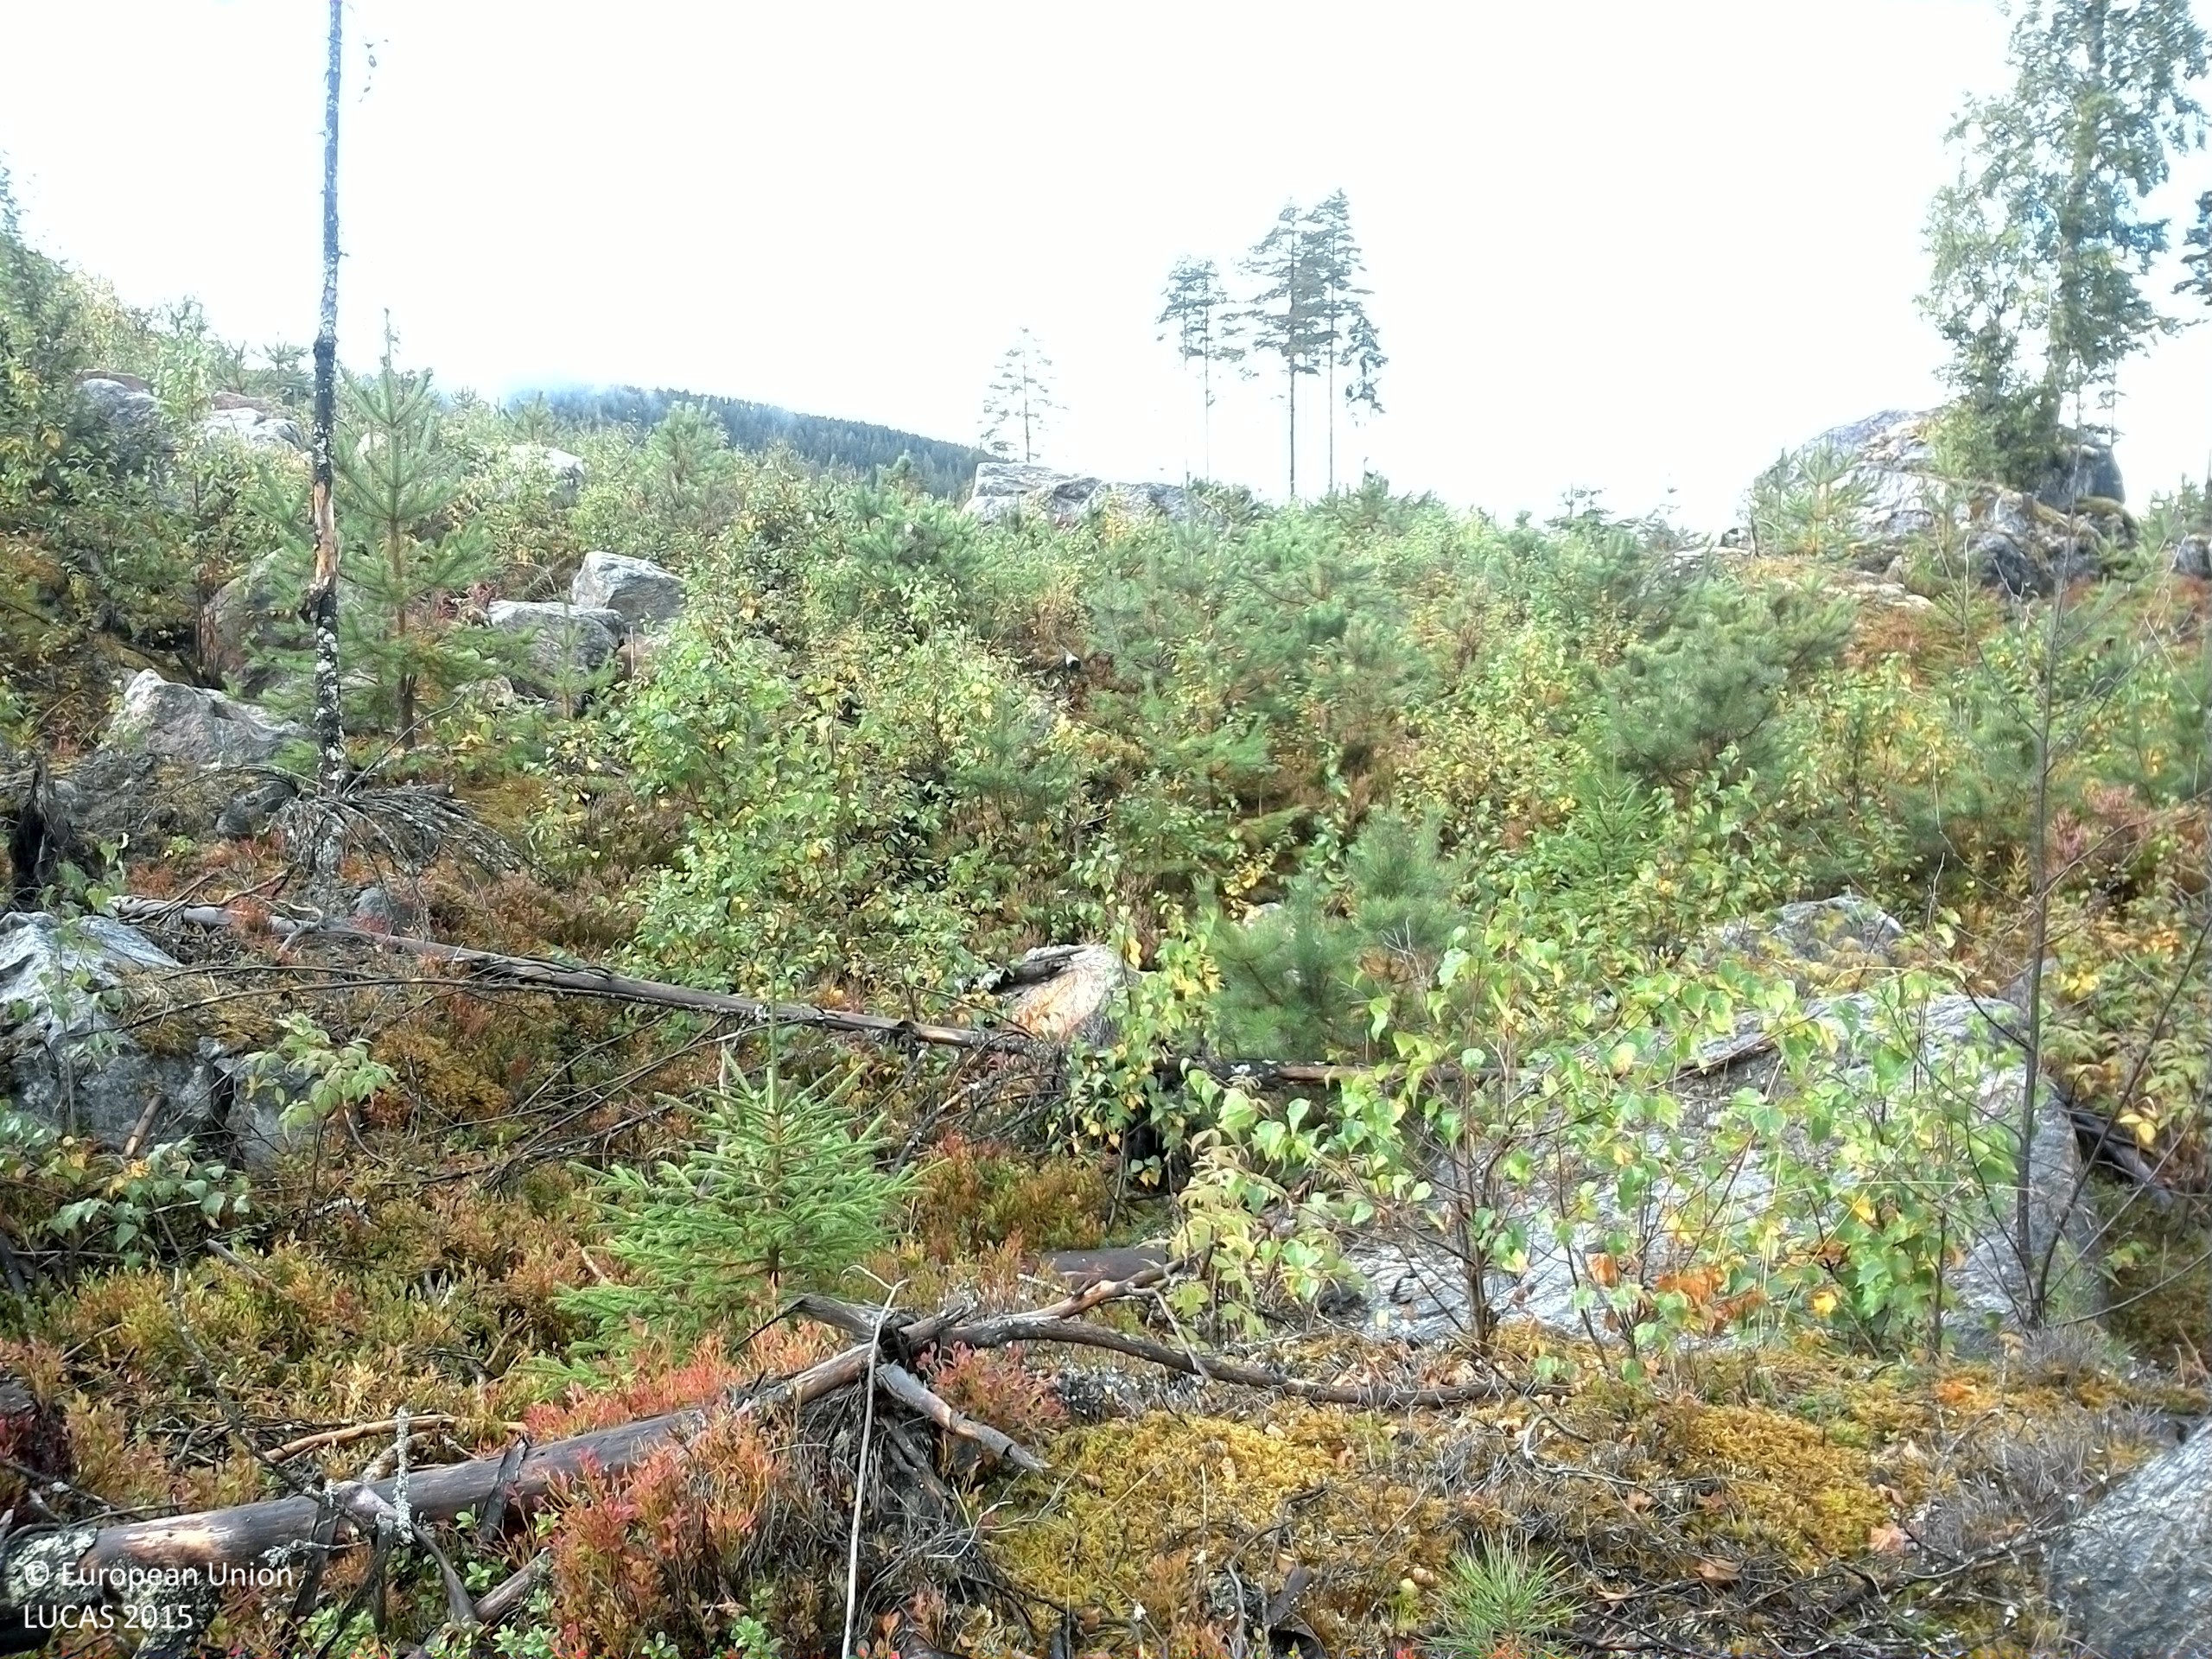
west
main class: Woodland
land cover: Pine dominated mixed woodland
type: boreal forest
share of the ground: 25 - 50 %
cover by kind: coniferous forest trees 30 %, shrubs 25 %, consolidated bare surface 20 %, broadleaved forest trees 15 %, lichens and mosses 10 %
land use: Forestry
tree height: < 5 m
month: September
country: SE
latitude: 61.1414
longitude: 15.4274
